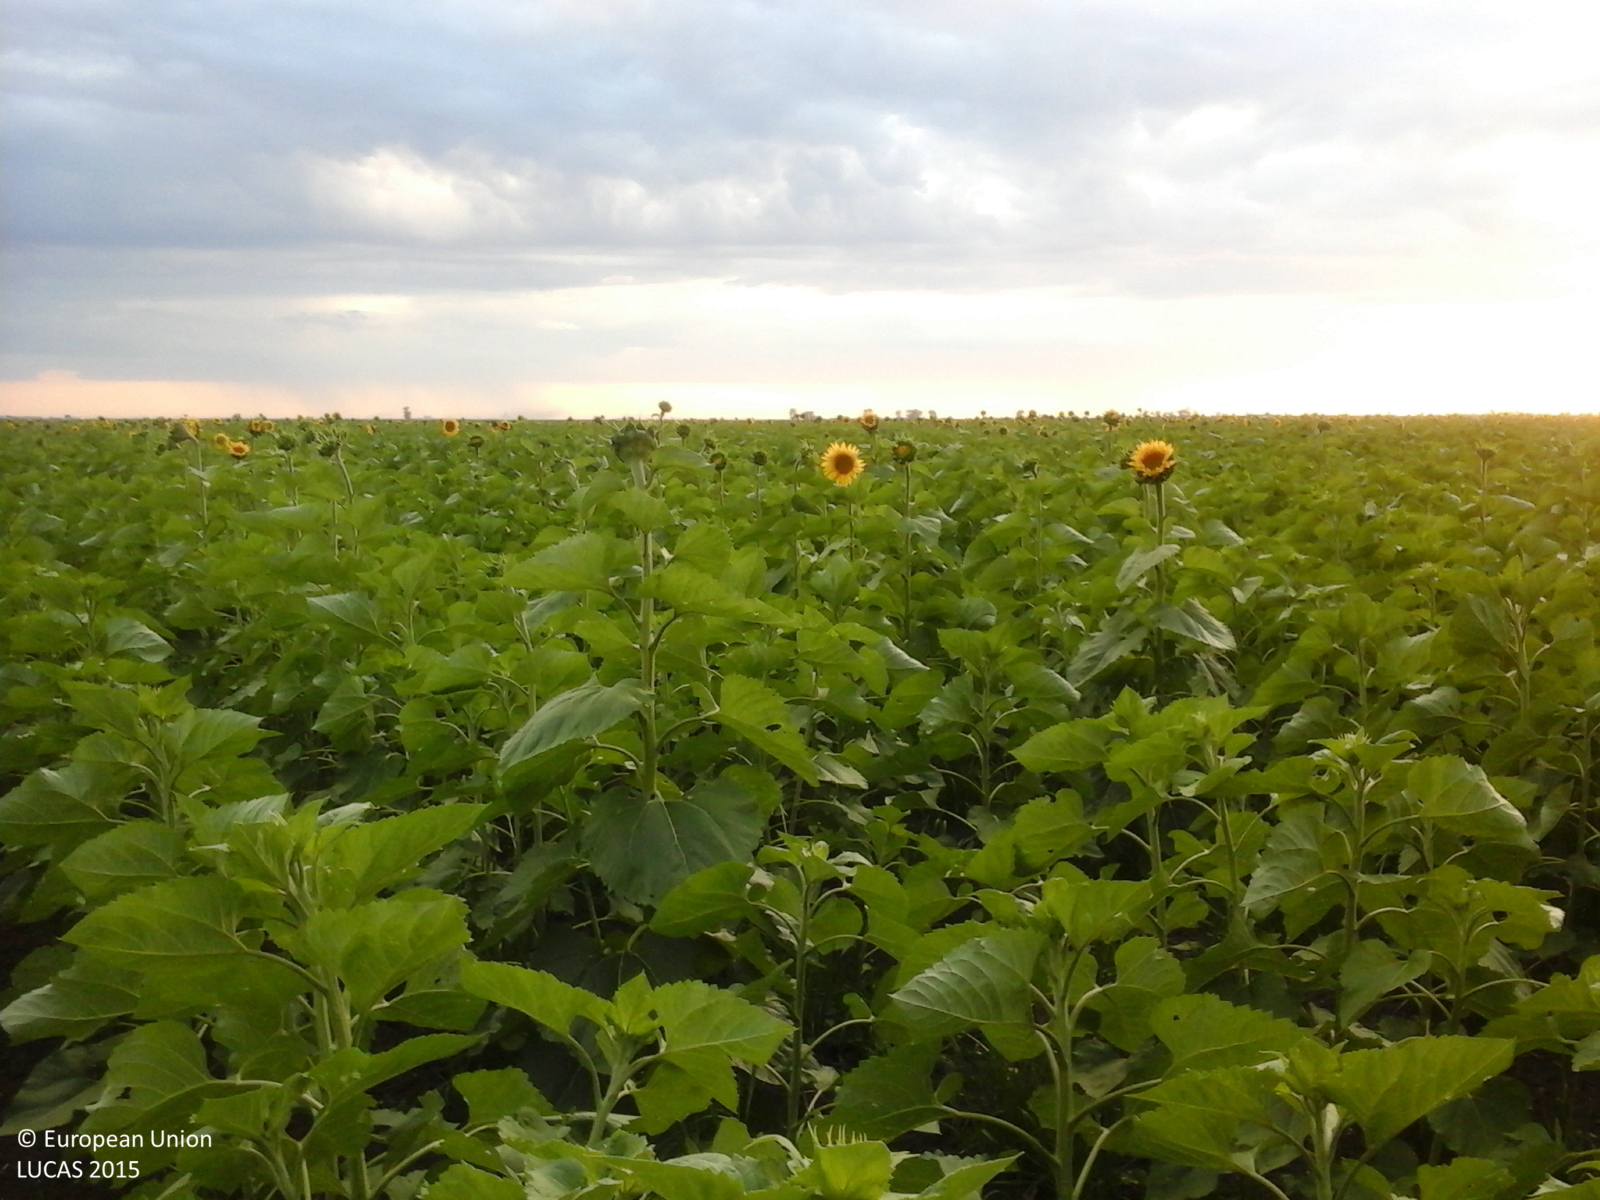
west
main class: Cropland
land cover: Sunflower
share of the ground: > 75 %
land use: Agriculture (excluding fallow land and kitchen gardens)
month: July
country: RO
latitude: 44.1413
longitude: 24.8120
